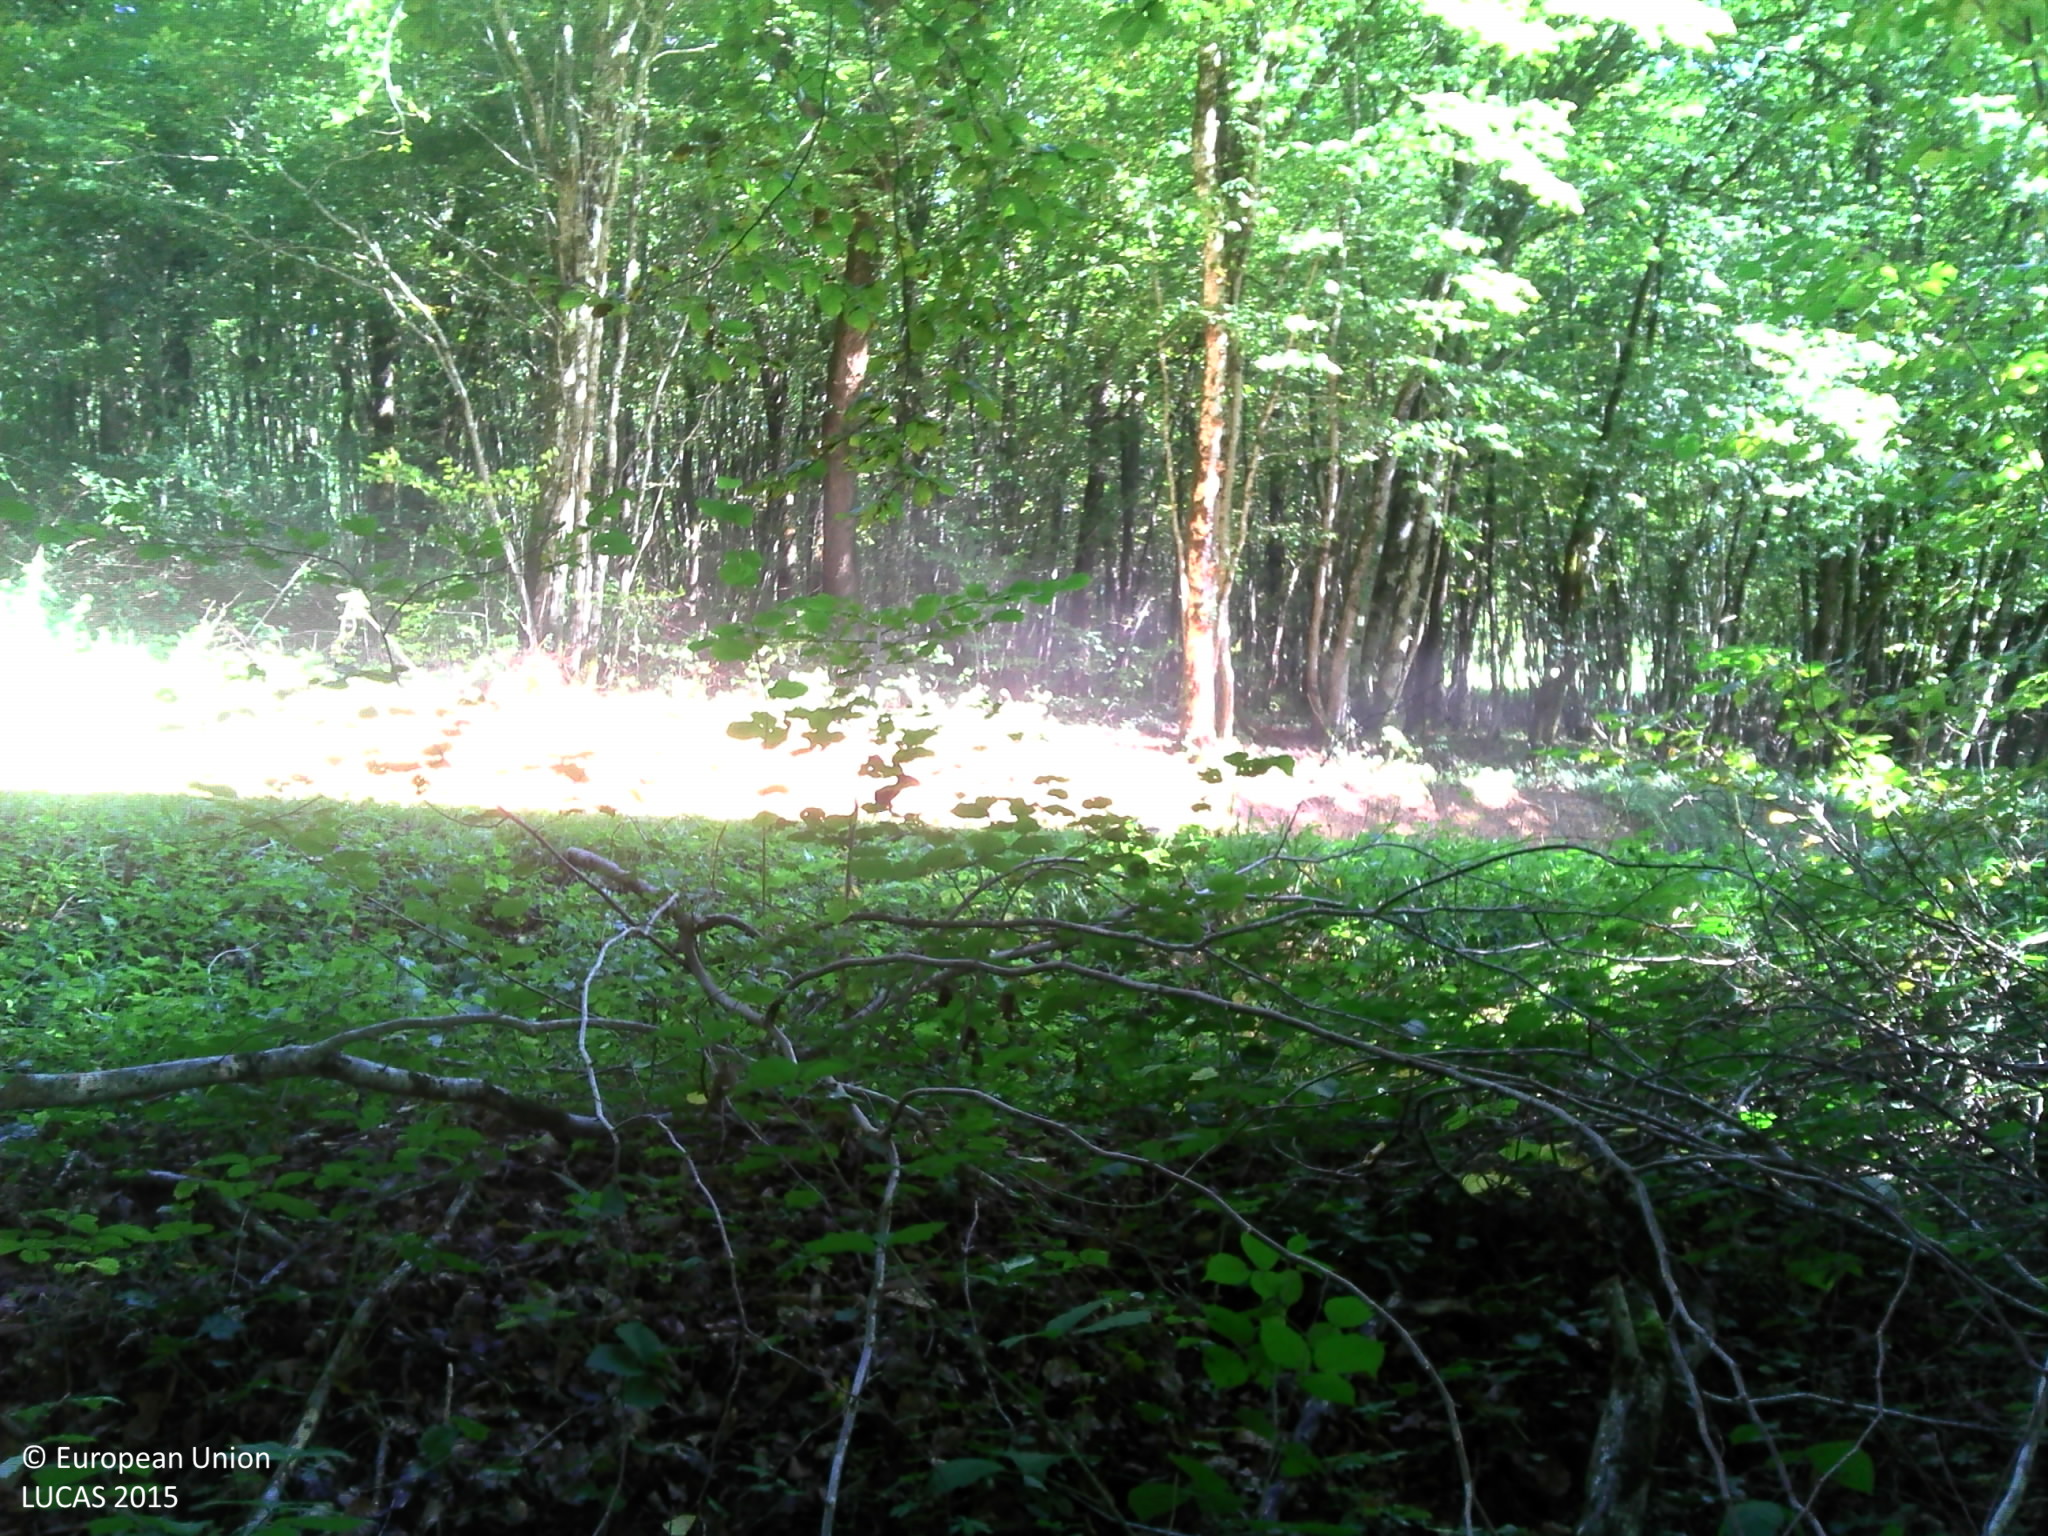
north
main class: Woodland
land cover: Broadleaved woodland
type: beech forest
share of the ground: > 75 %
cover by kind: broadleaved forest trees 80 %, herbaceous plants 15 %, shrubs 5 %
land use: Forestry
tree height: > 5 m
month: September
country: FR
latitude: 47.3690
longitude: 6.3071
